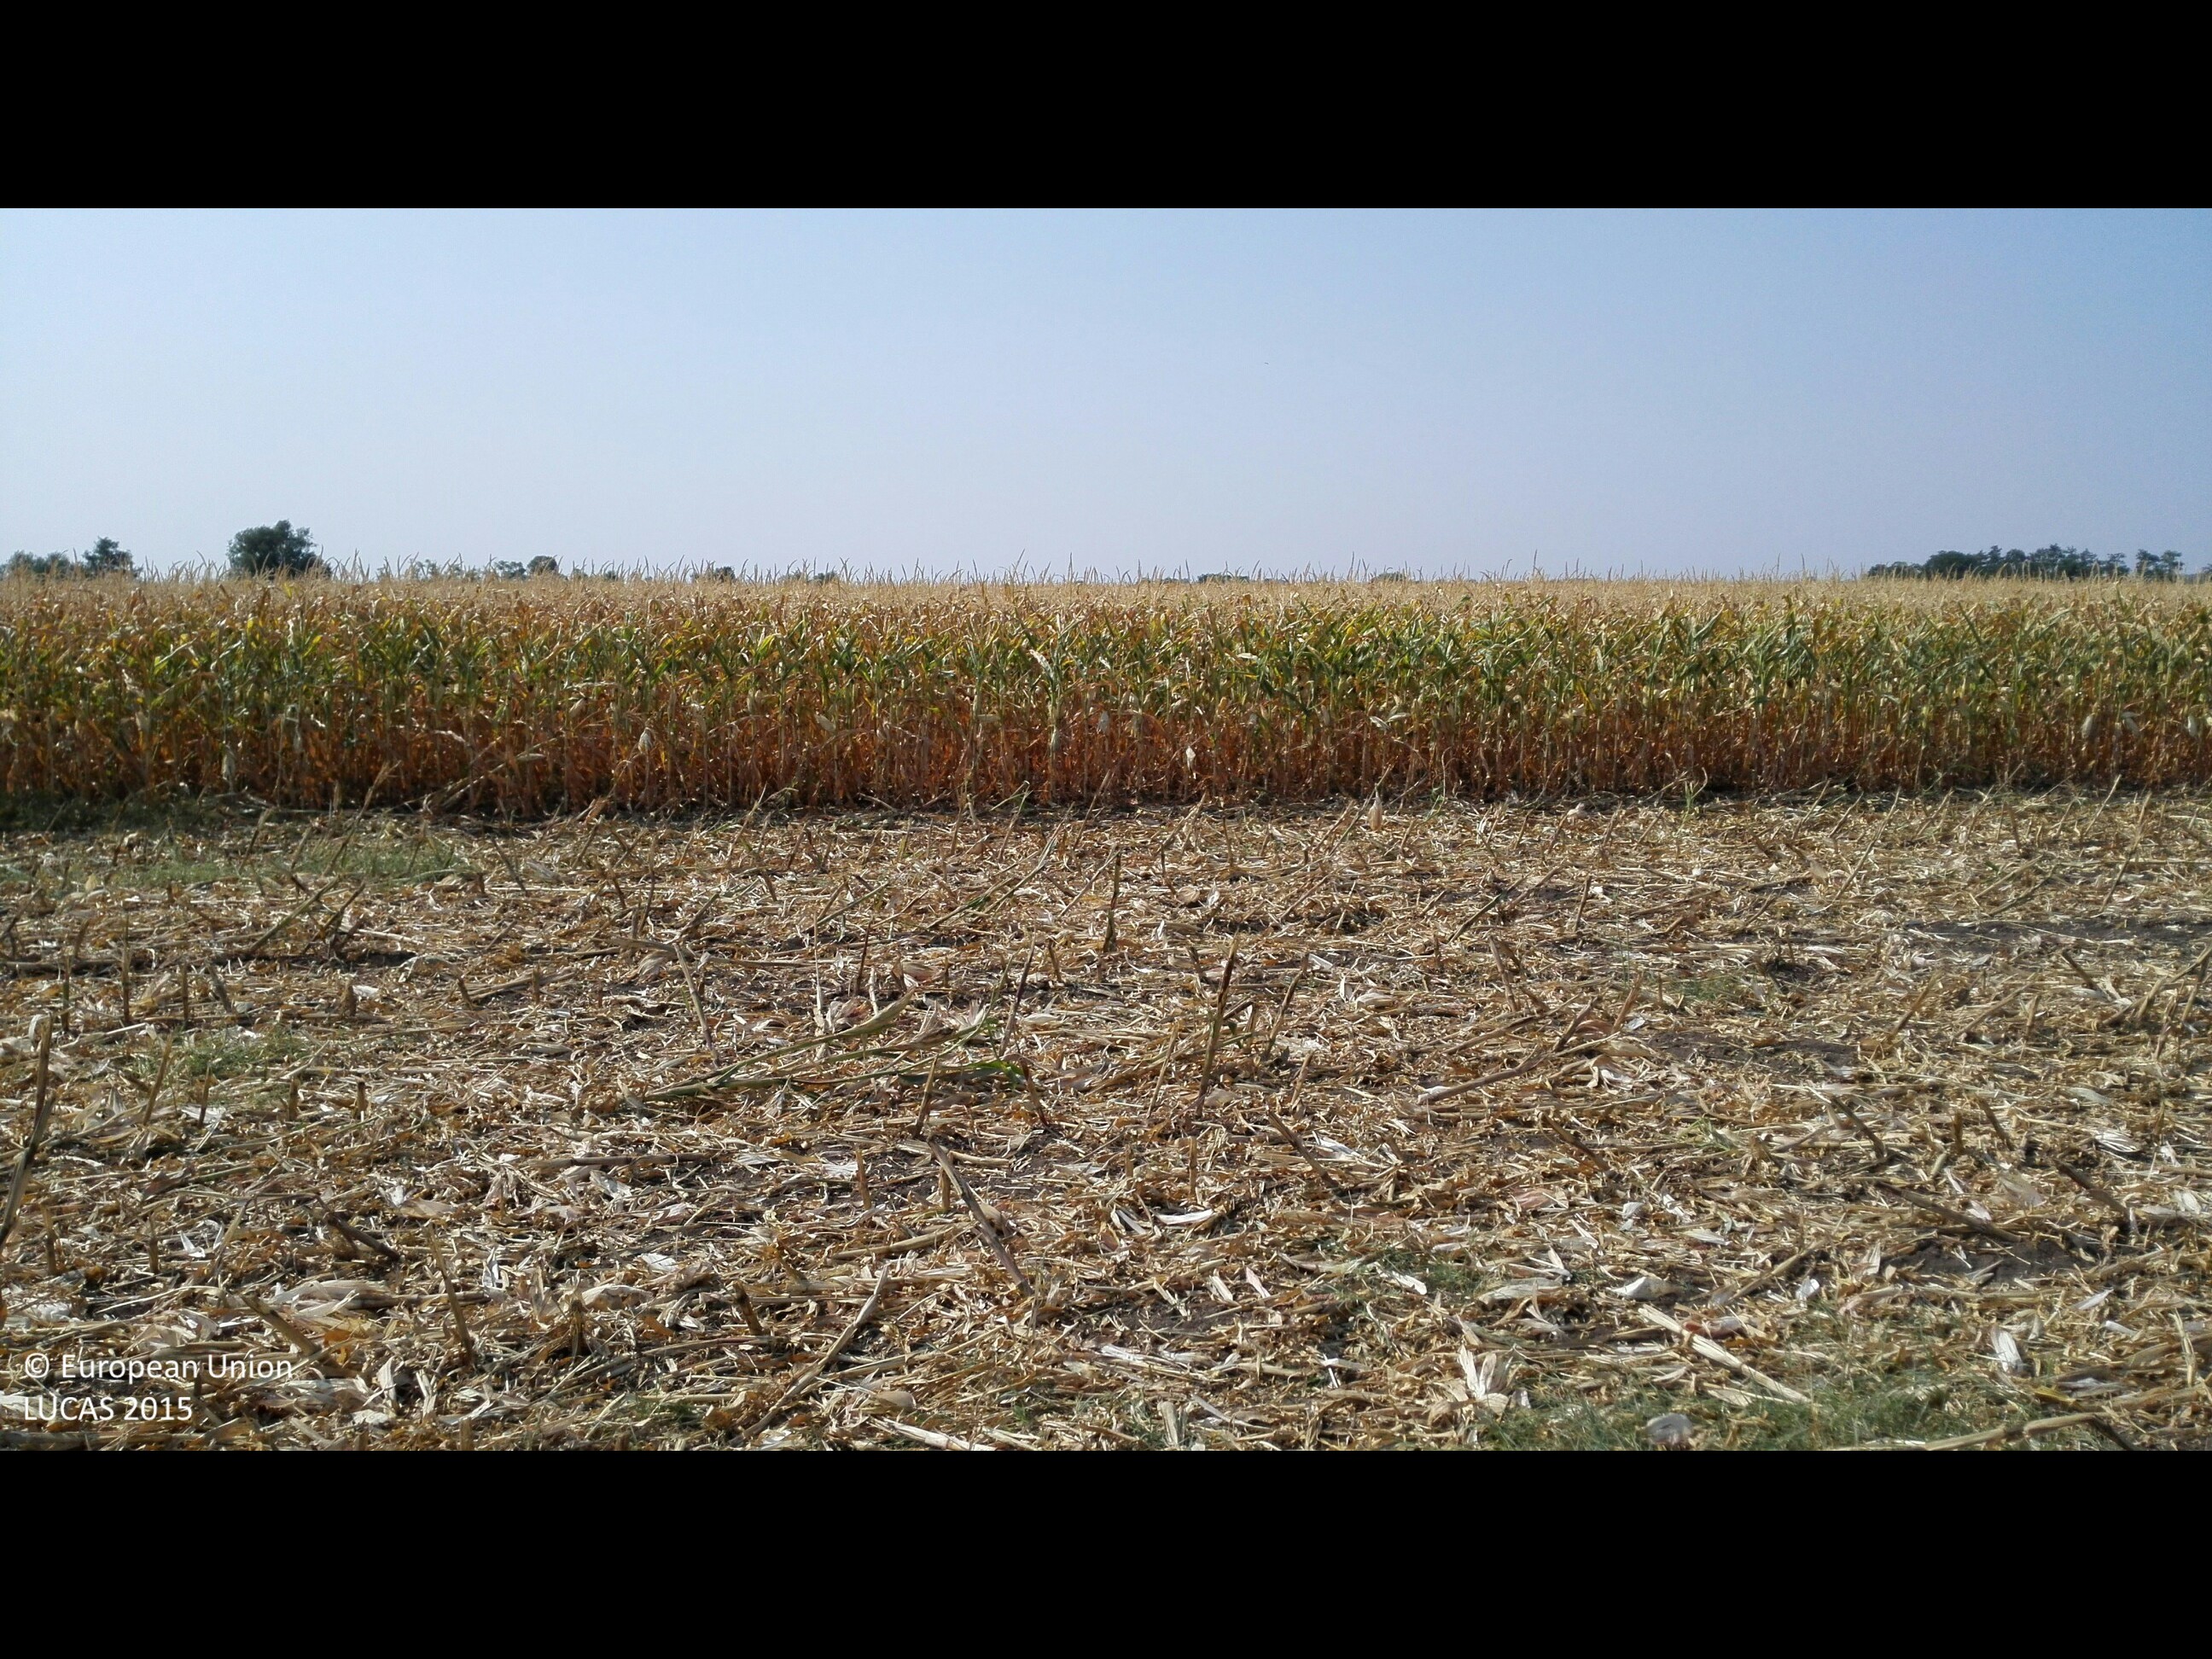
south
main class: Cropland
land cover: Maize
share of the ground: 10 - 25 %
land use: Agriculture (excluding fallow land and kitchen gardens)
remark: Harvested field
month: August
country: HU
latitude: 47.4607
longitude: 21.6249
